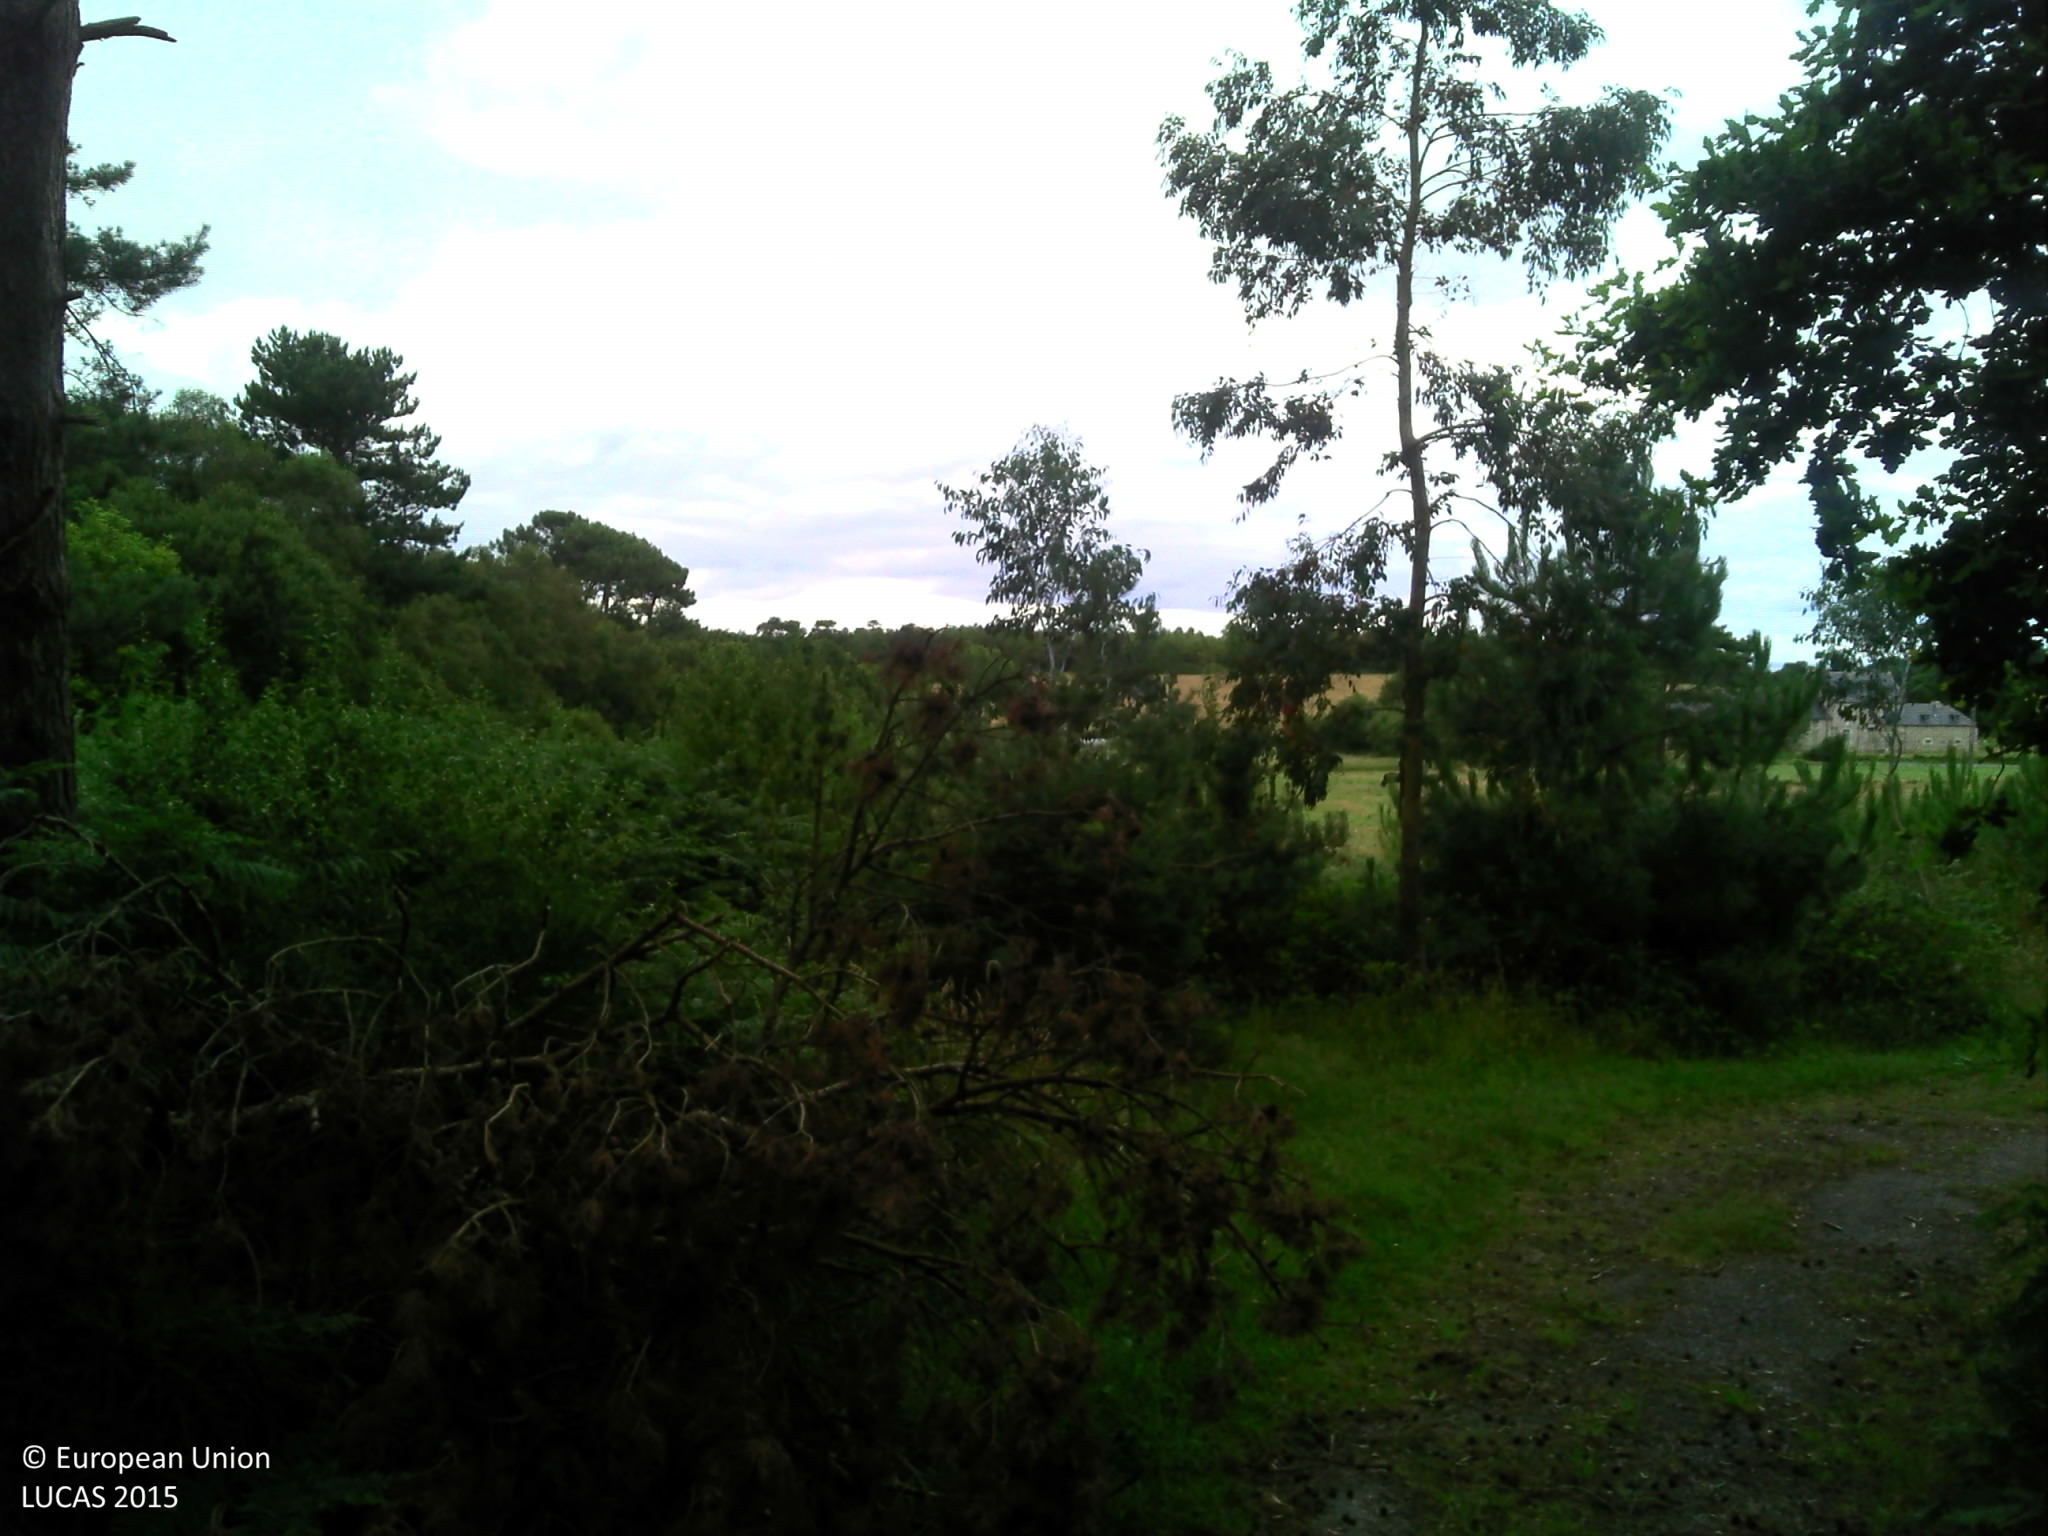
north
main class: Woodland
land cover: Pine dominated mixed woodland
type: exotic forest
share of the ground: > 75 %
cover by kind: herbaceous plants 40 %, unconsolidated bare surface 20 %, coniferous forest trees 15 %, broadleaved forest trees 15 %, lichens and mosses 10 %
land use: Forestry
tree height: > 5 m
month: July
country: FR
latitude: 48.6429
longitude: -2.4526
